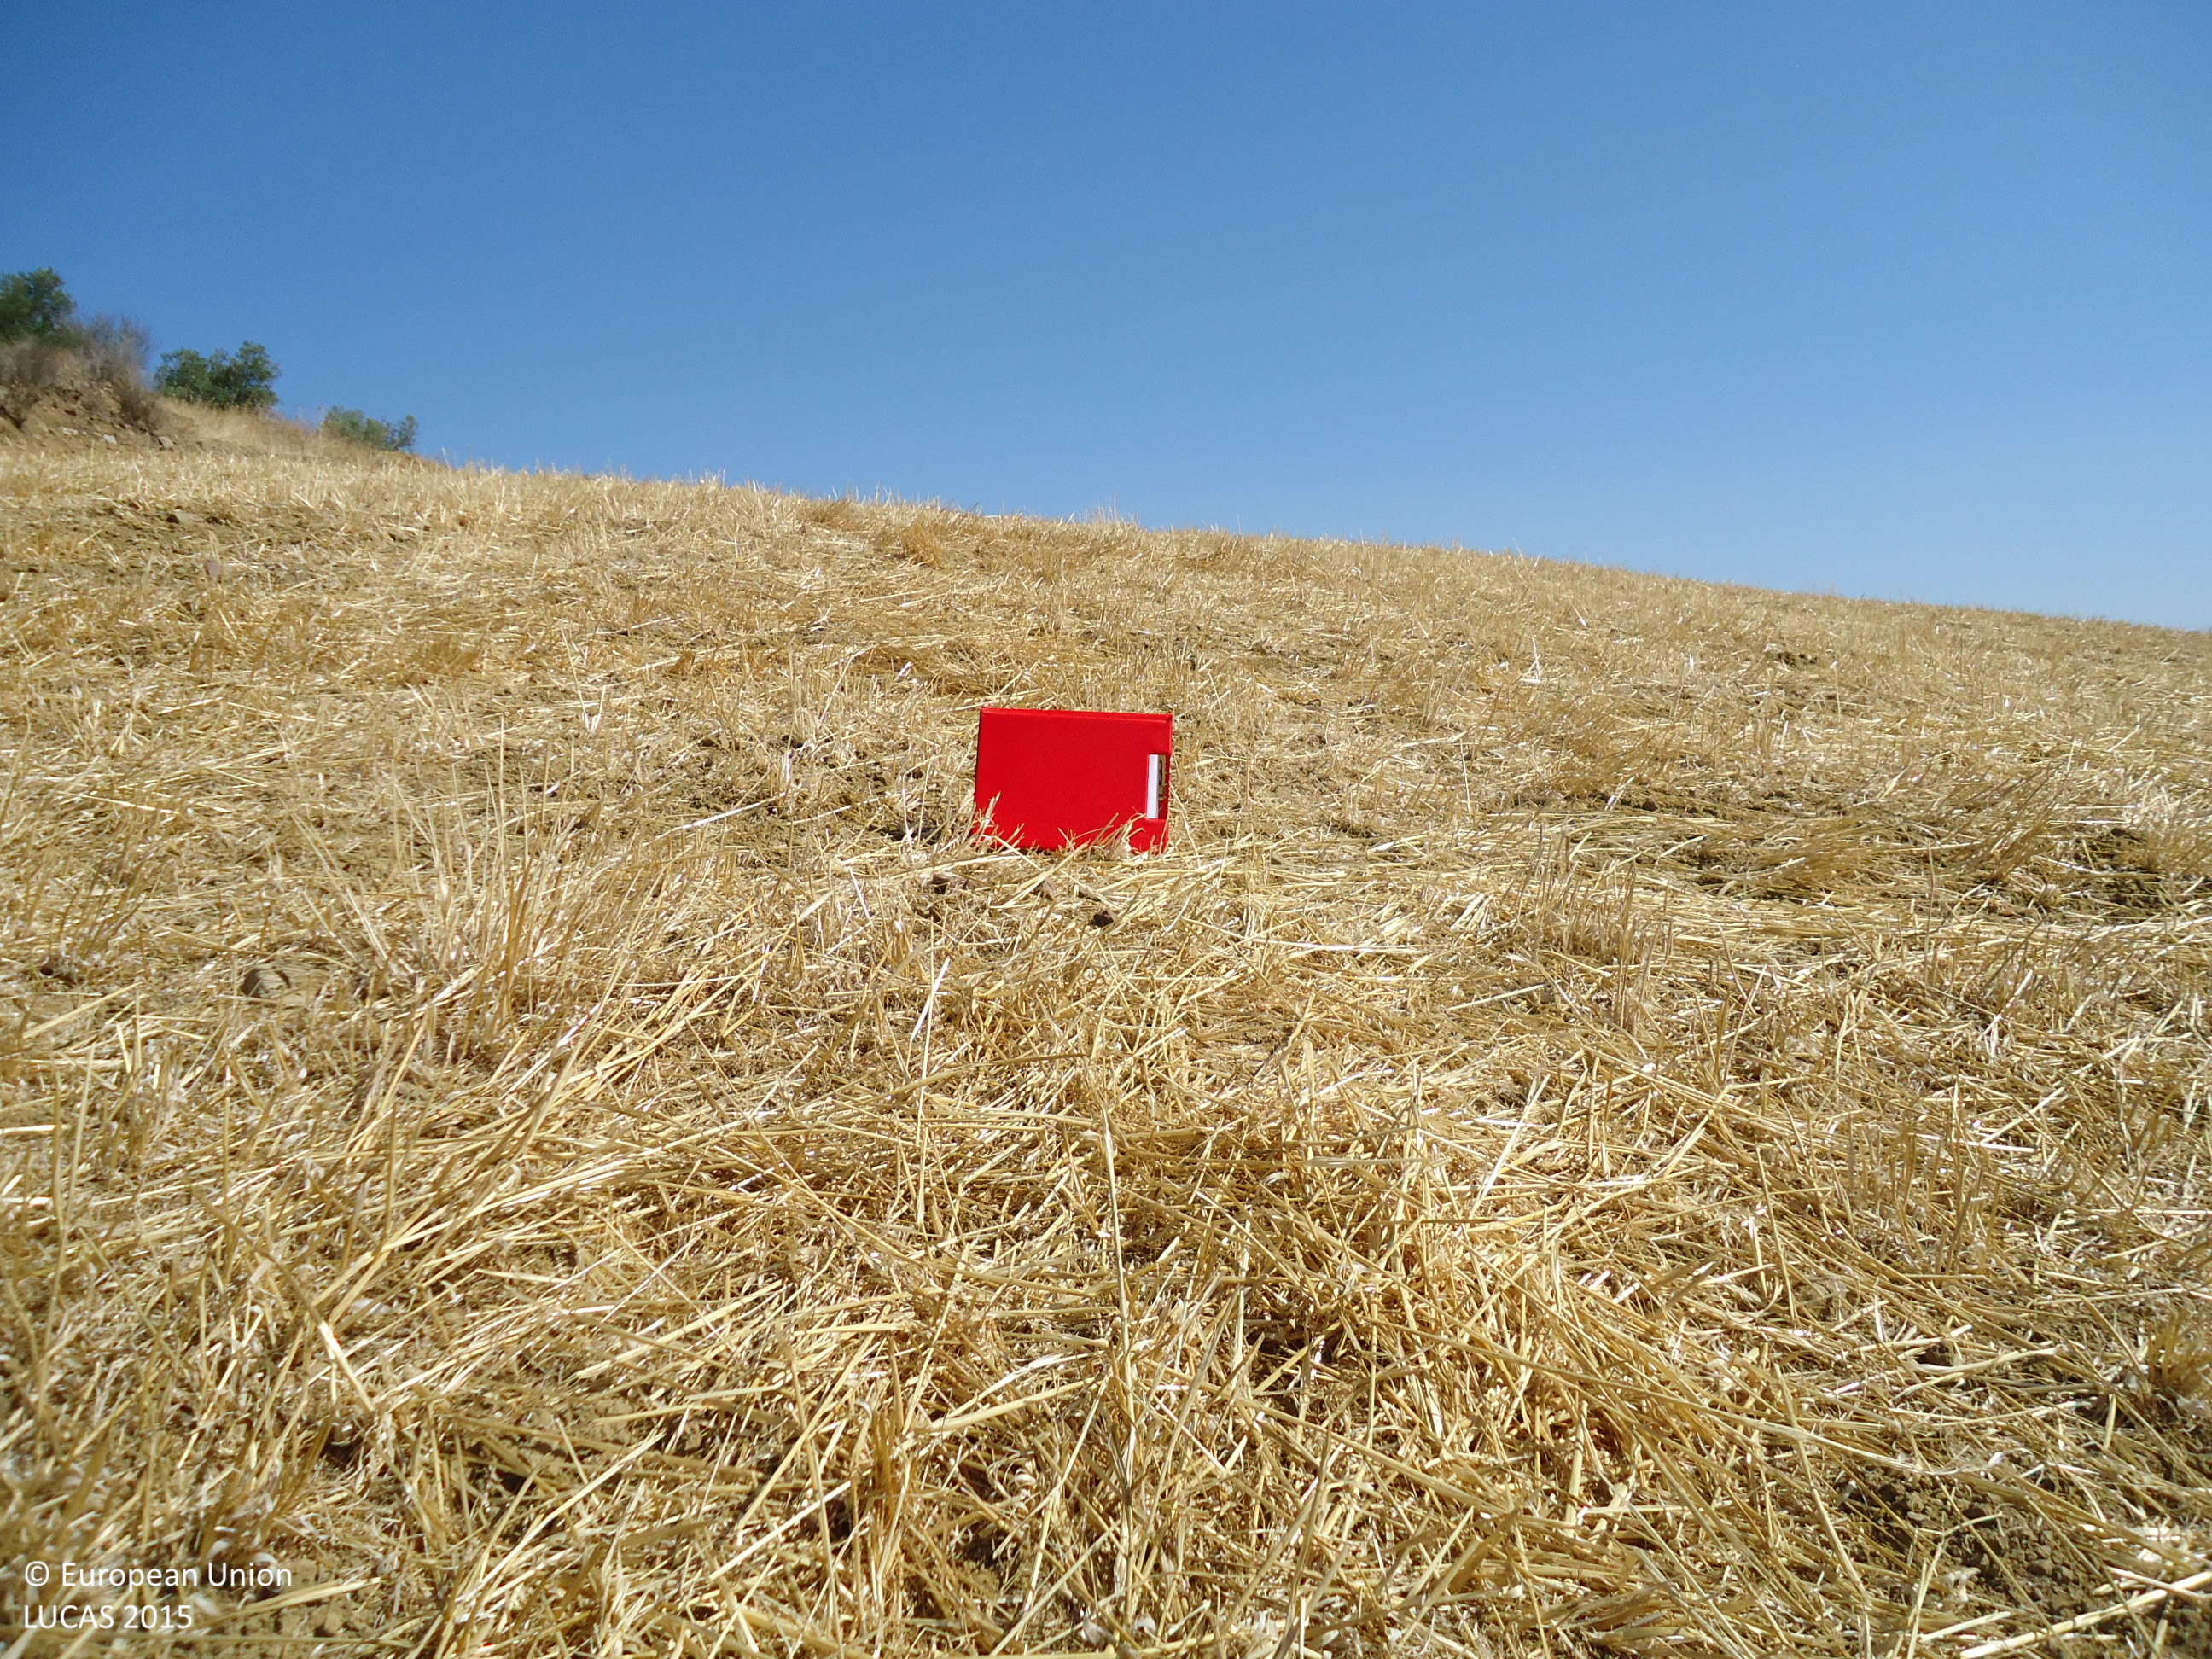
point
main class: Cropland
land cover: Durum wheat
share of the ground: < 10 %
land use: Agriculture (excluding fallow land and kitchen gardens)
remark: Harvested field
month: June
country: ES
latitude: 36.7210
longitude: -4.7389
